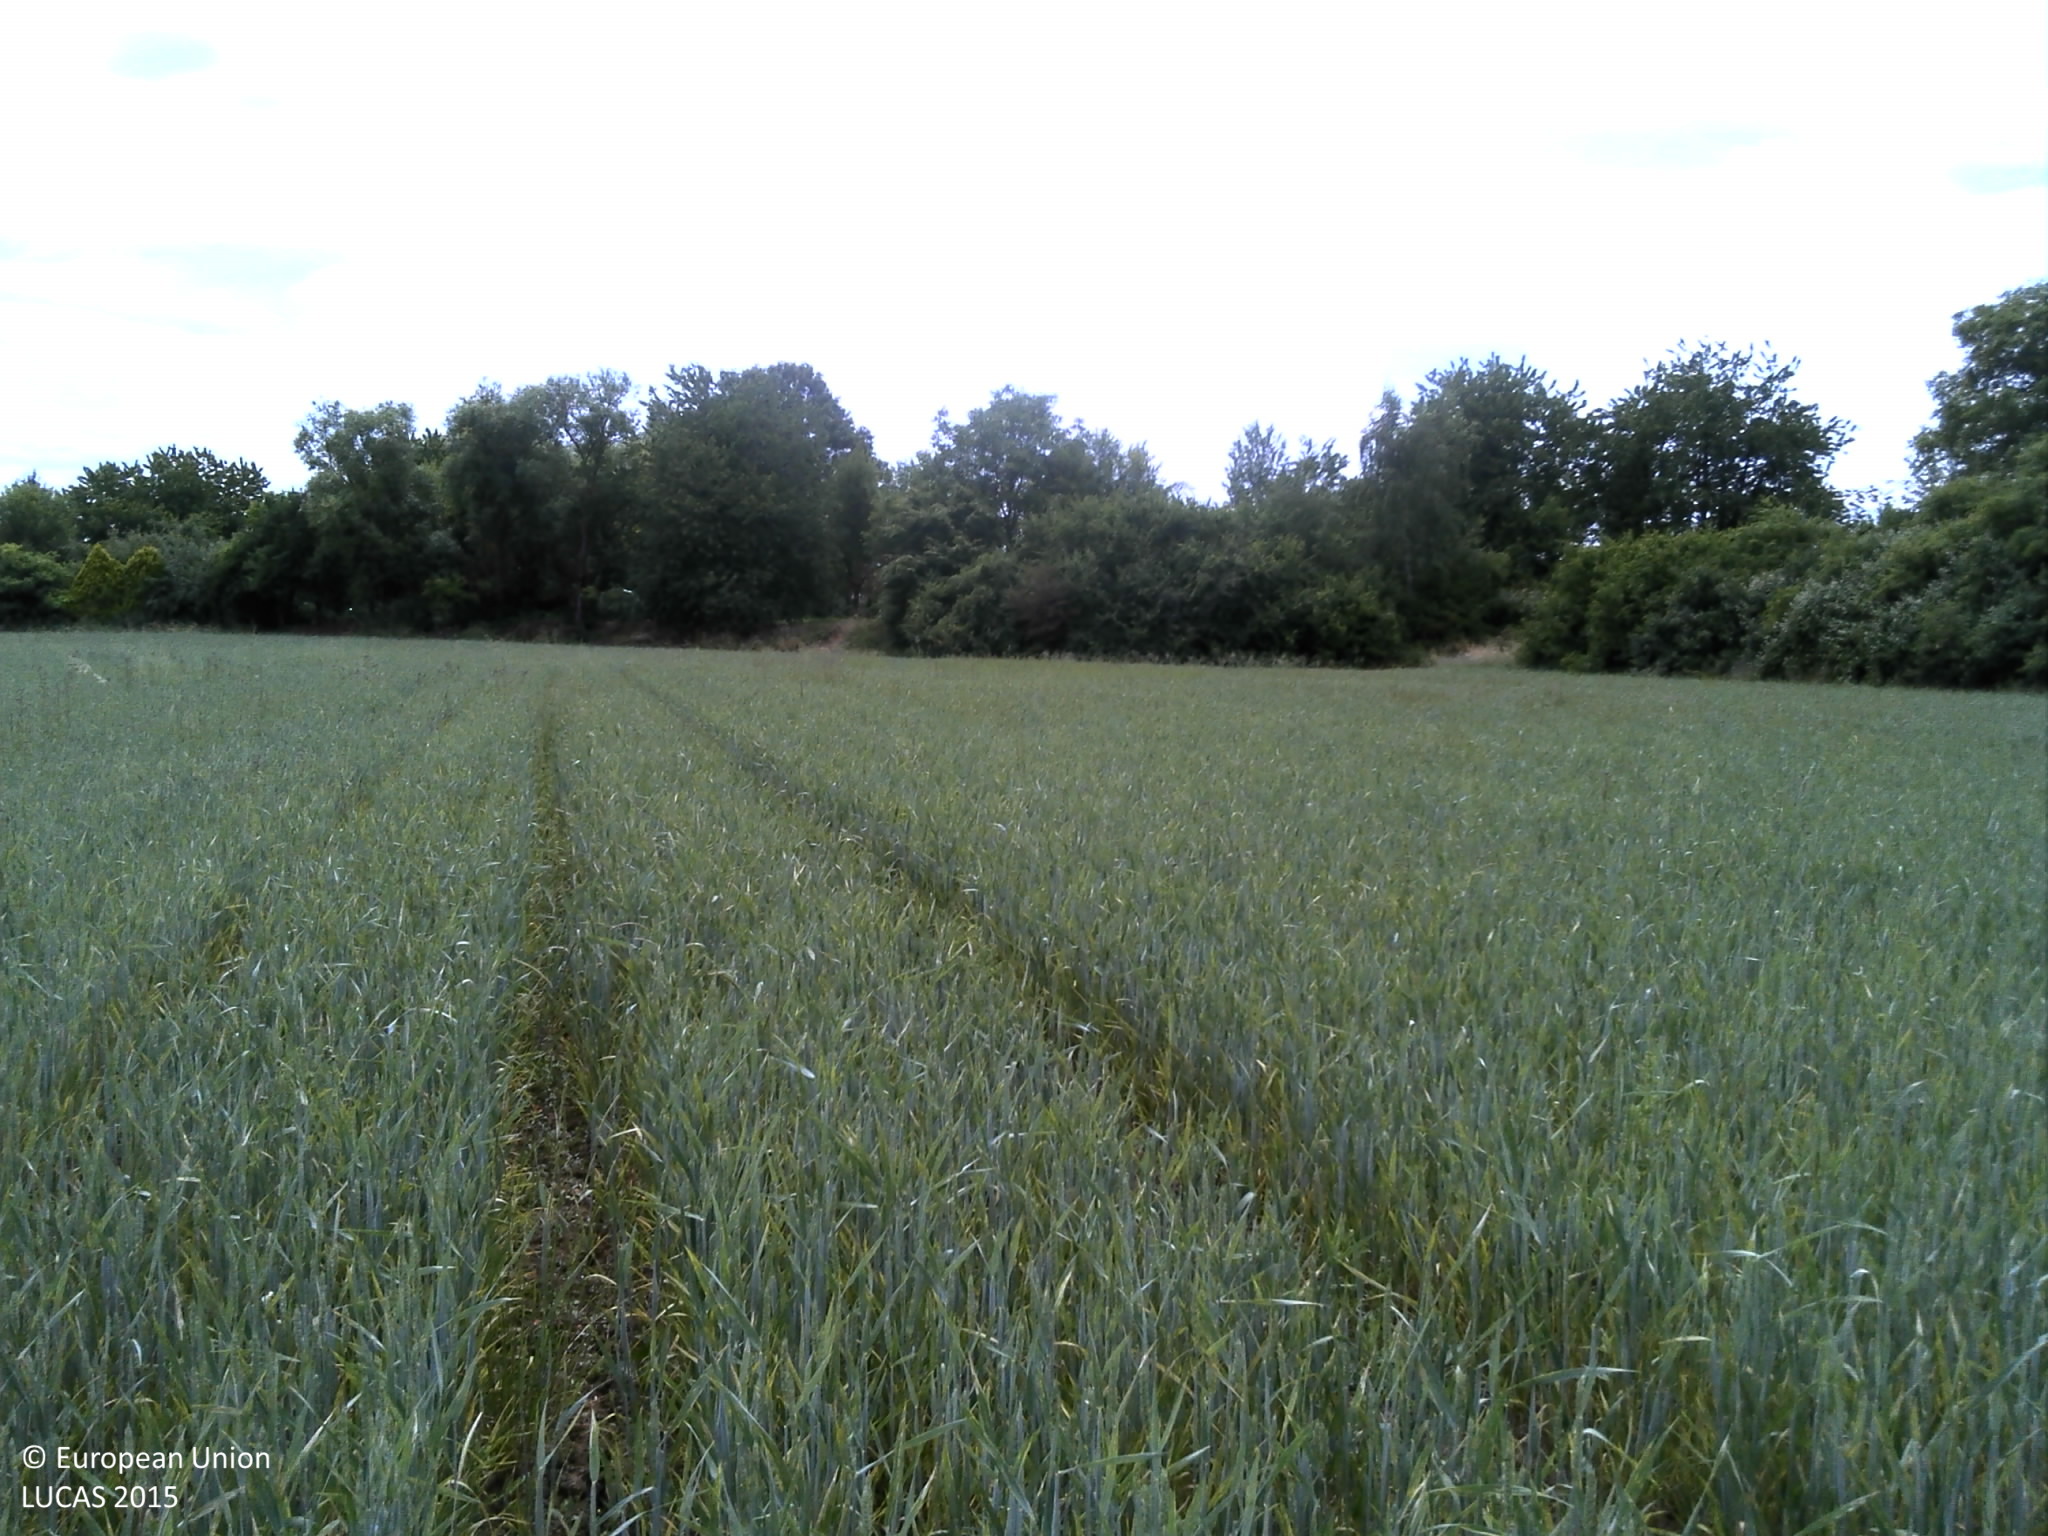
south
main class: Cropland
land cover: Barley
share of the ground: > 75 %
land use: Agriculture (excluding fallow land and kitchen gardens)
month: June
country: FR
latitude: 49.3113
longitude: 6.2170
